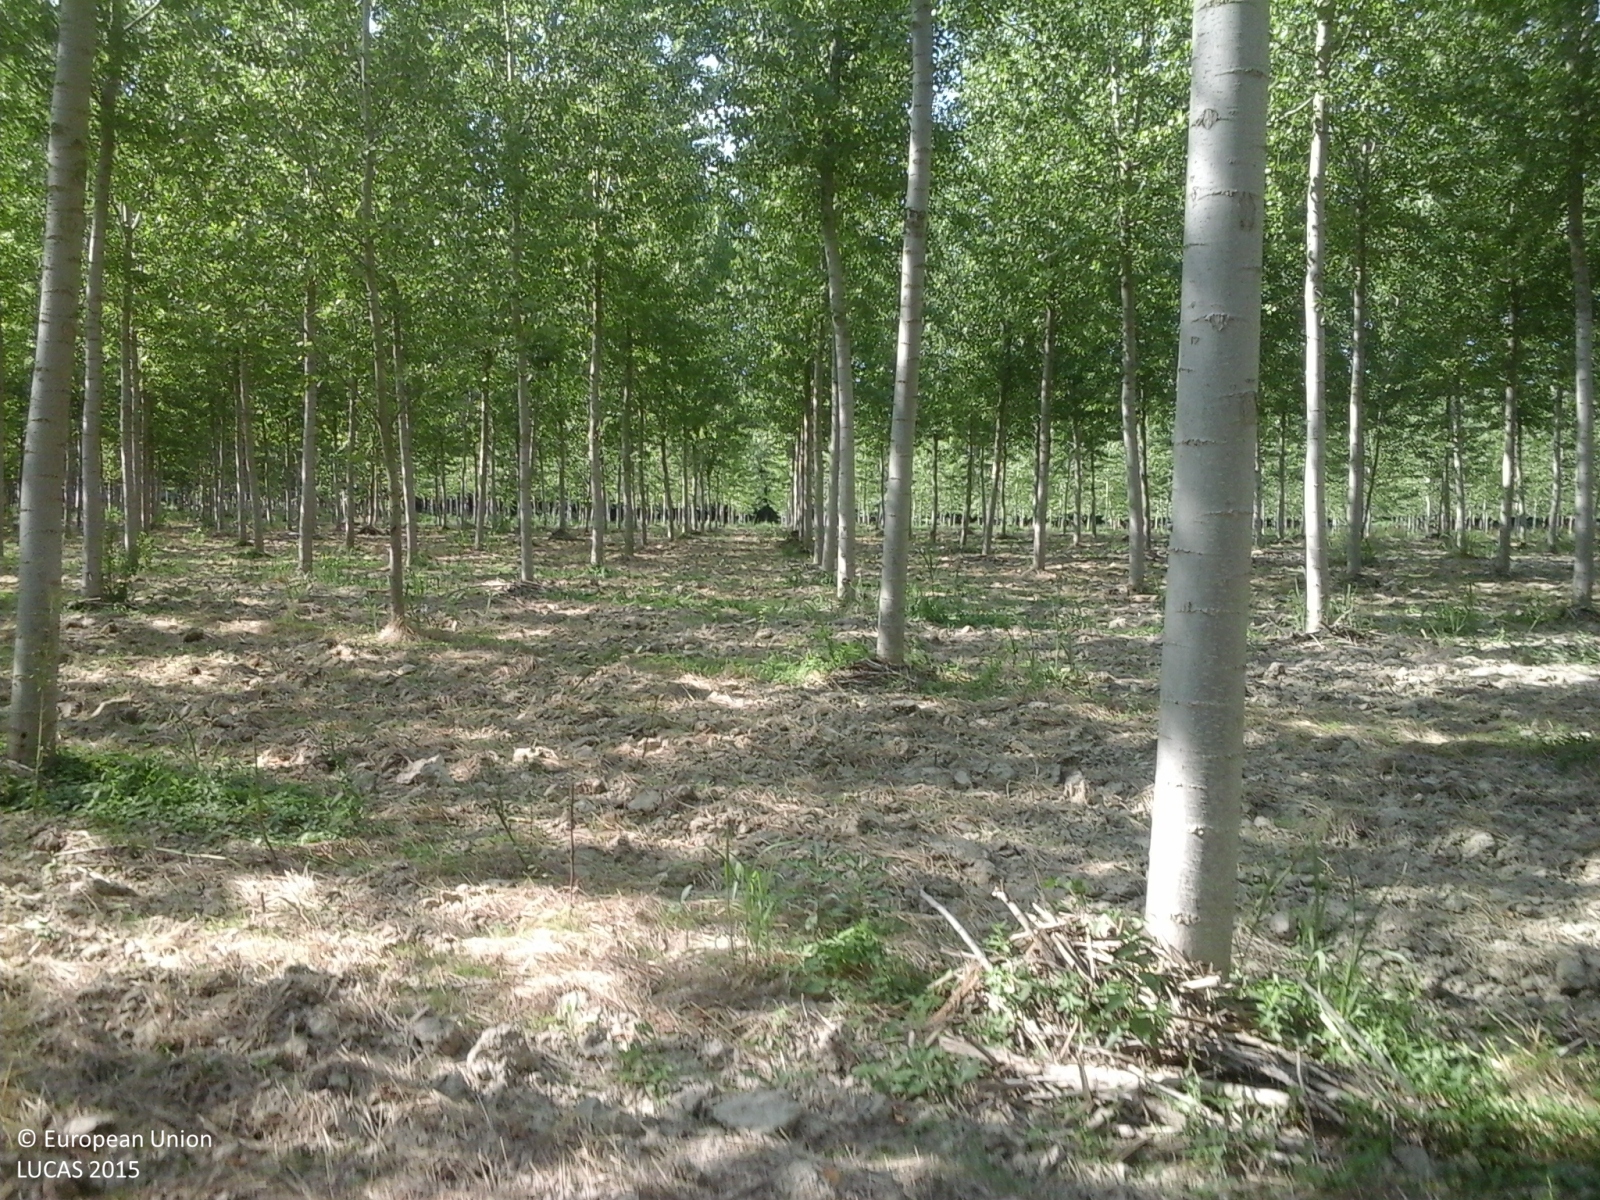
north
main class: Woodland
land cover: Broadleaved woodland
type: non-riverine alder, birch or aspen forest
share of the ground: > 75 %
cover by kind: broadleaved forest trees 85 %, unconsolidated bare surface 15 %
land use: Forestry
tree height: > 5 m
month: June
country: IT
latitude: 44.9739
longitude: 8.7218
